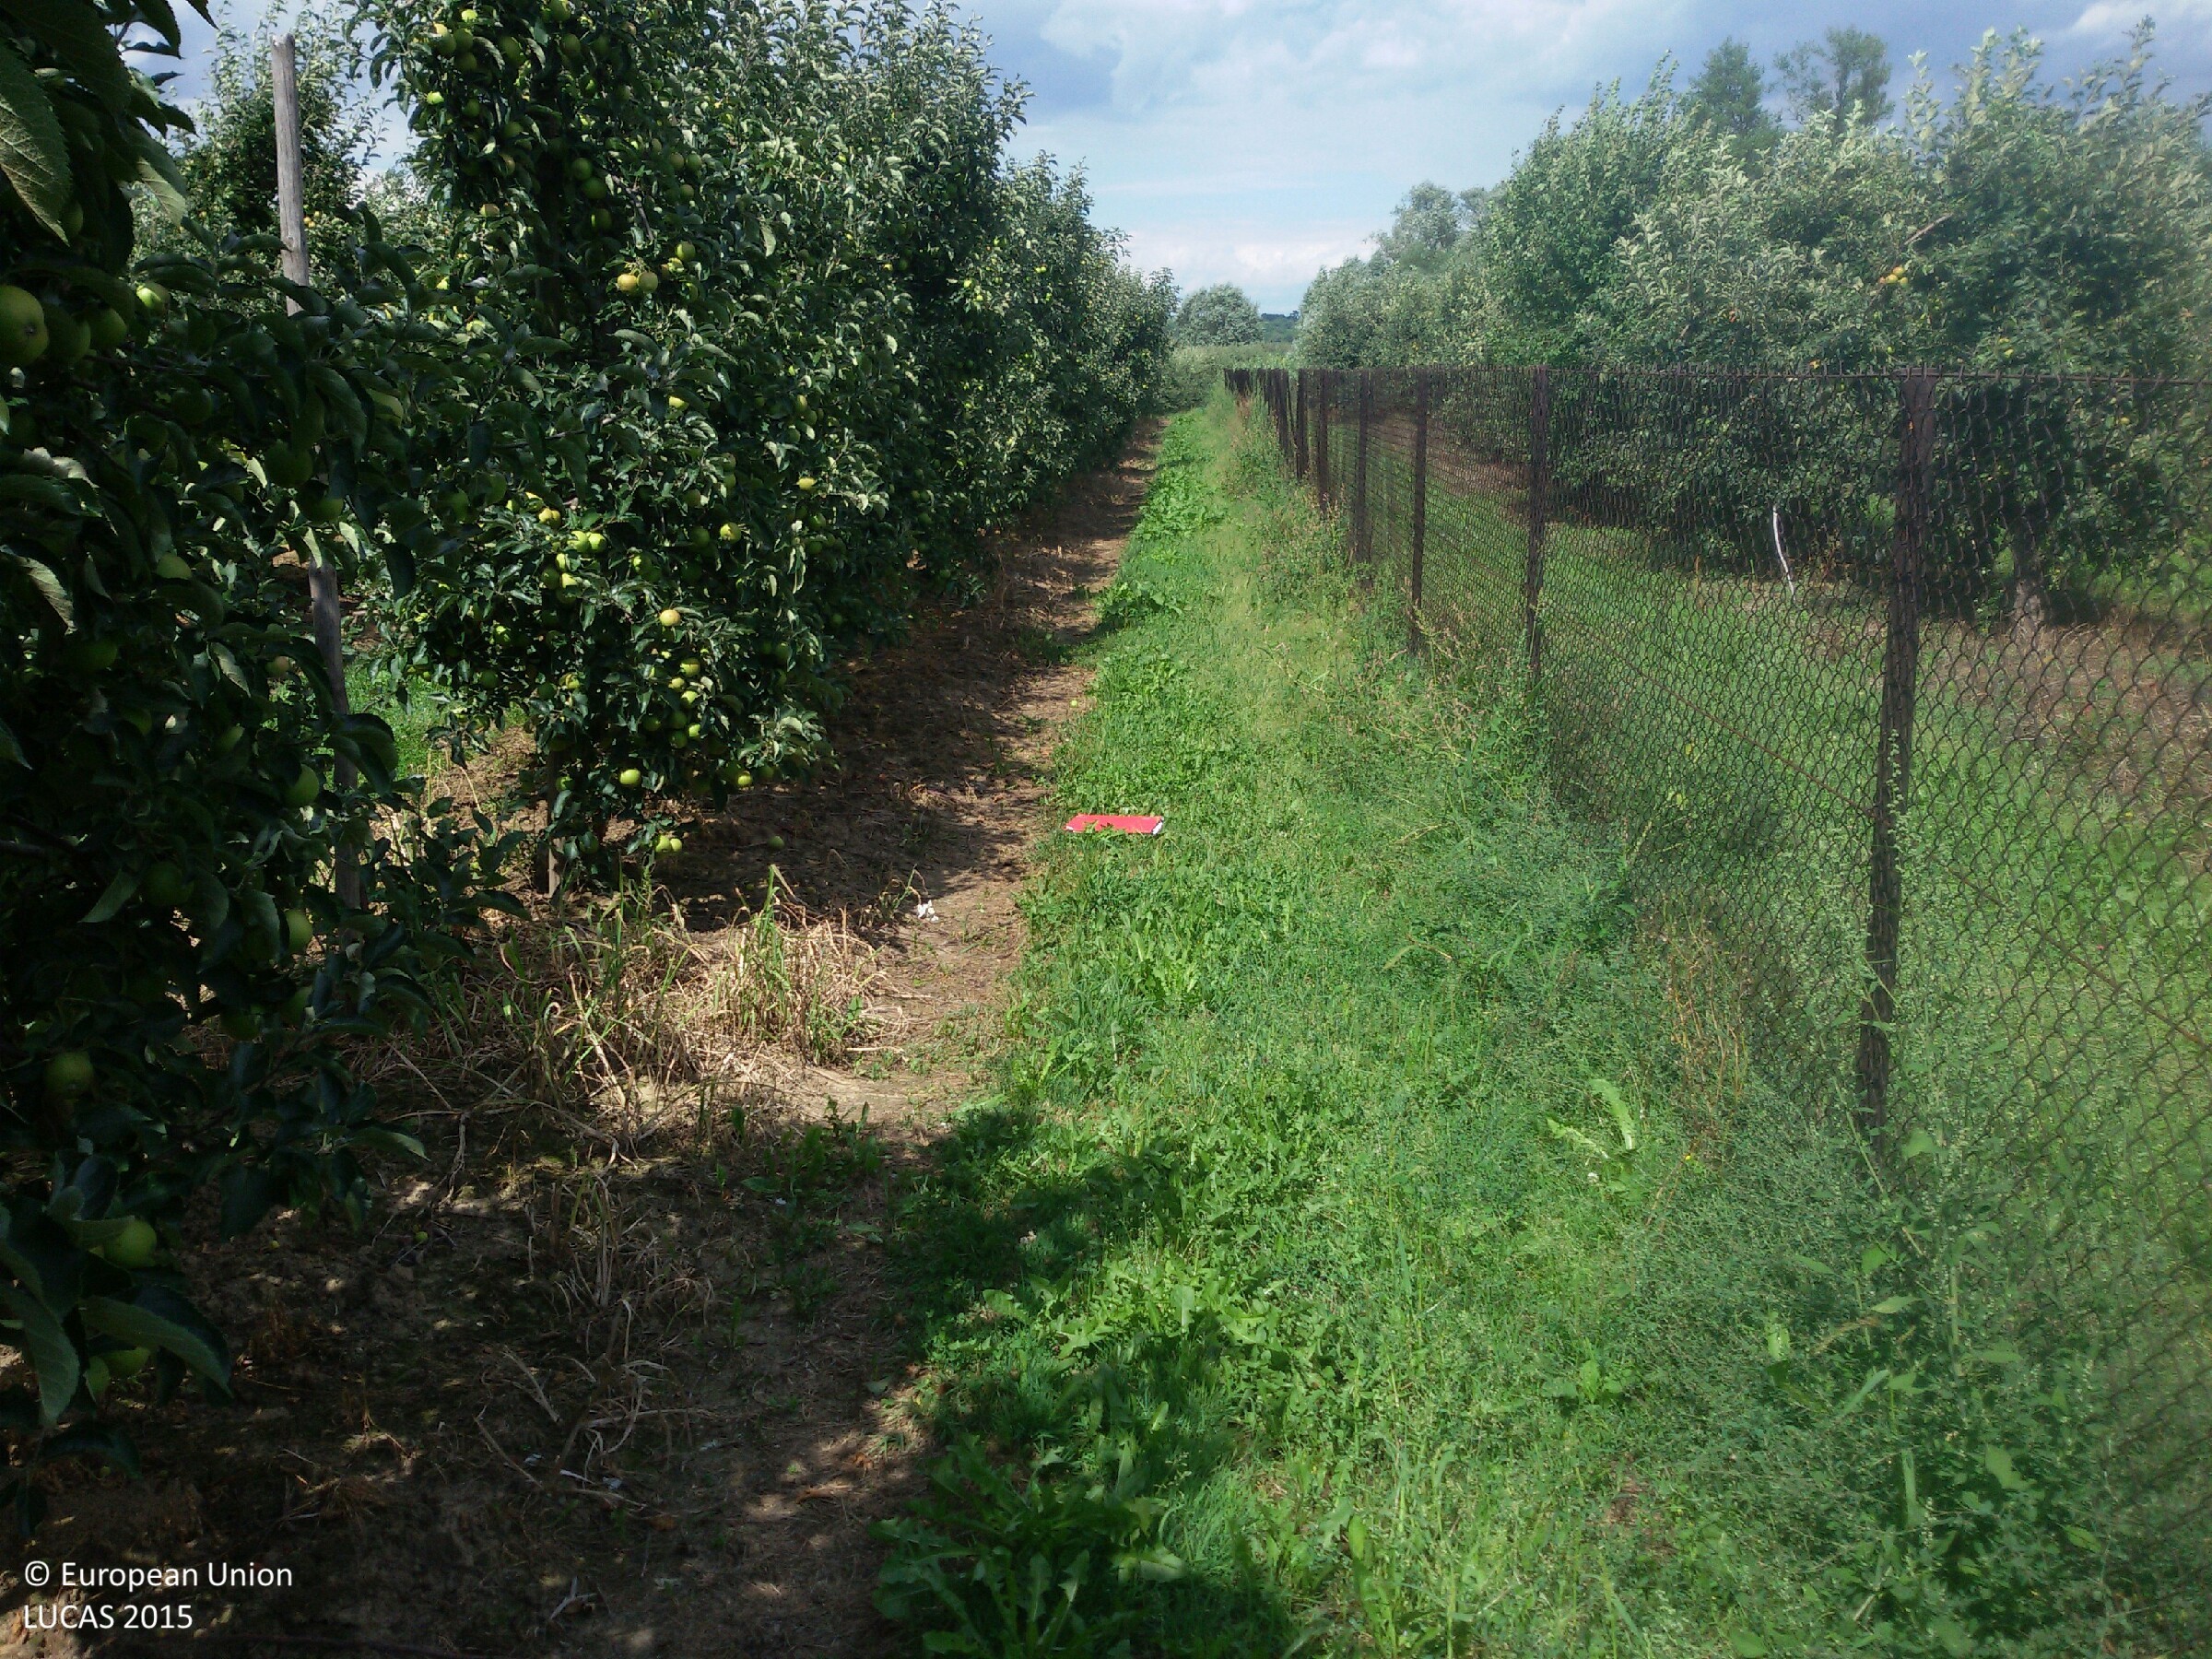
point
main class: Cropland
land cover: Apple fruit
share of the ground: > 75 %
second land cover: Grassland without tree/shrub cover
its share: > 75 %
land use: Agriculture (excluding fallow land and kitchen gardens)
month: July
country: PL
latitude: 50.6374
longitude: 21.6616
